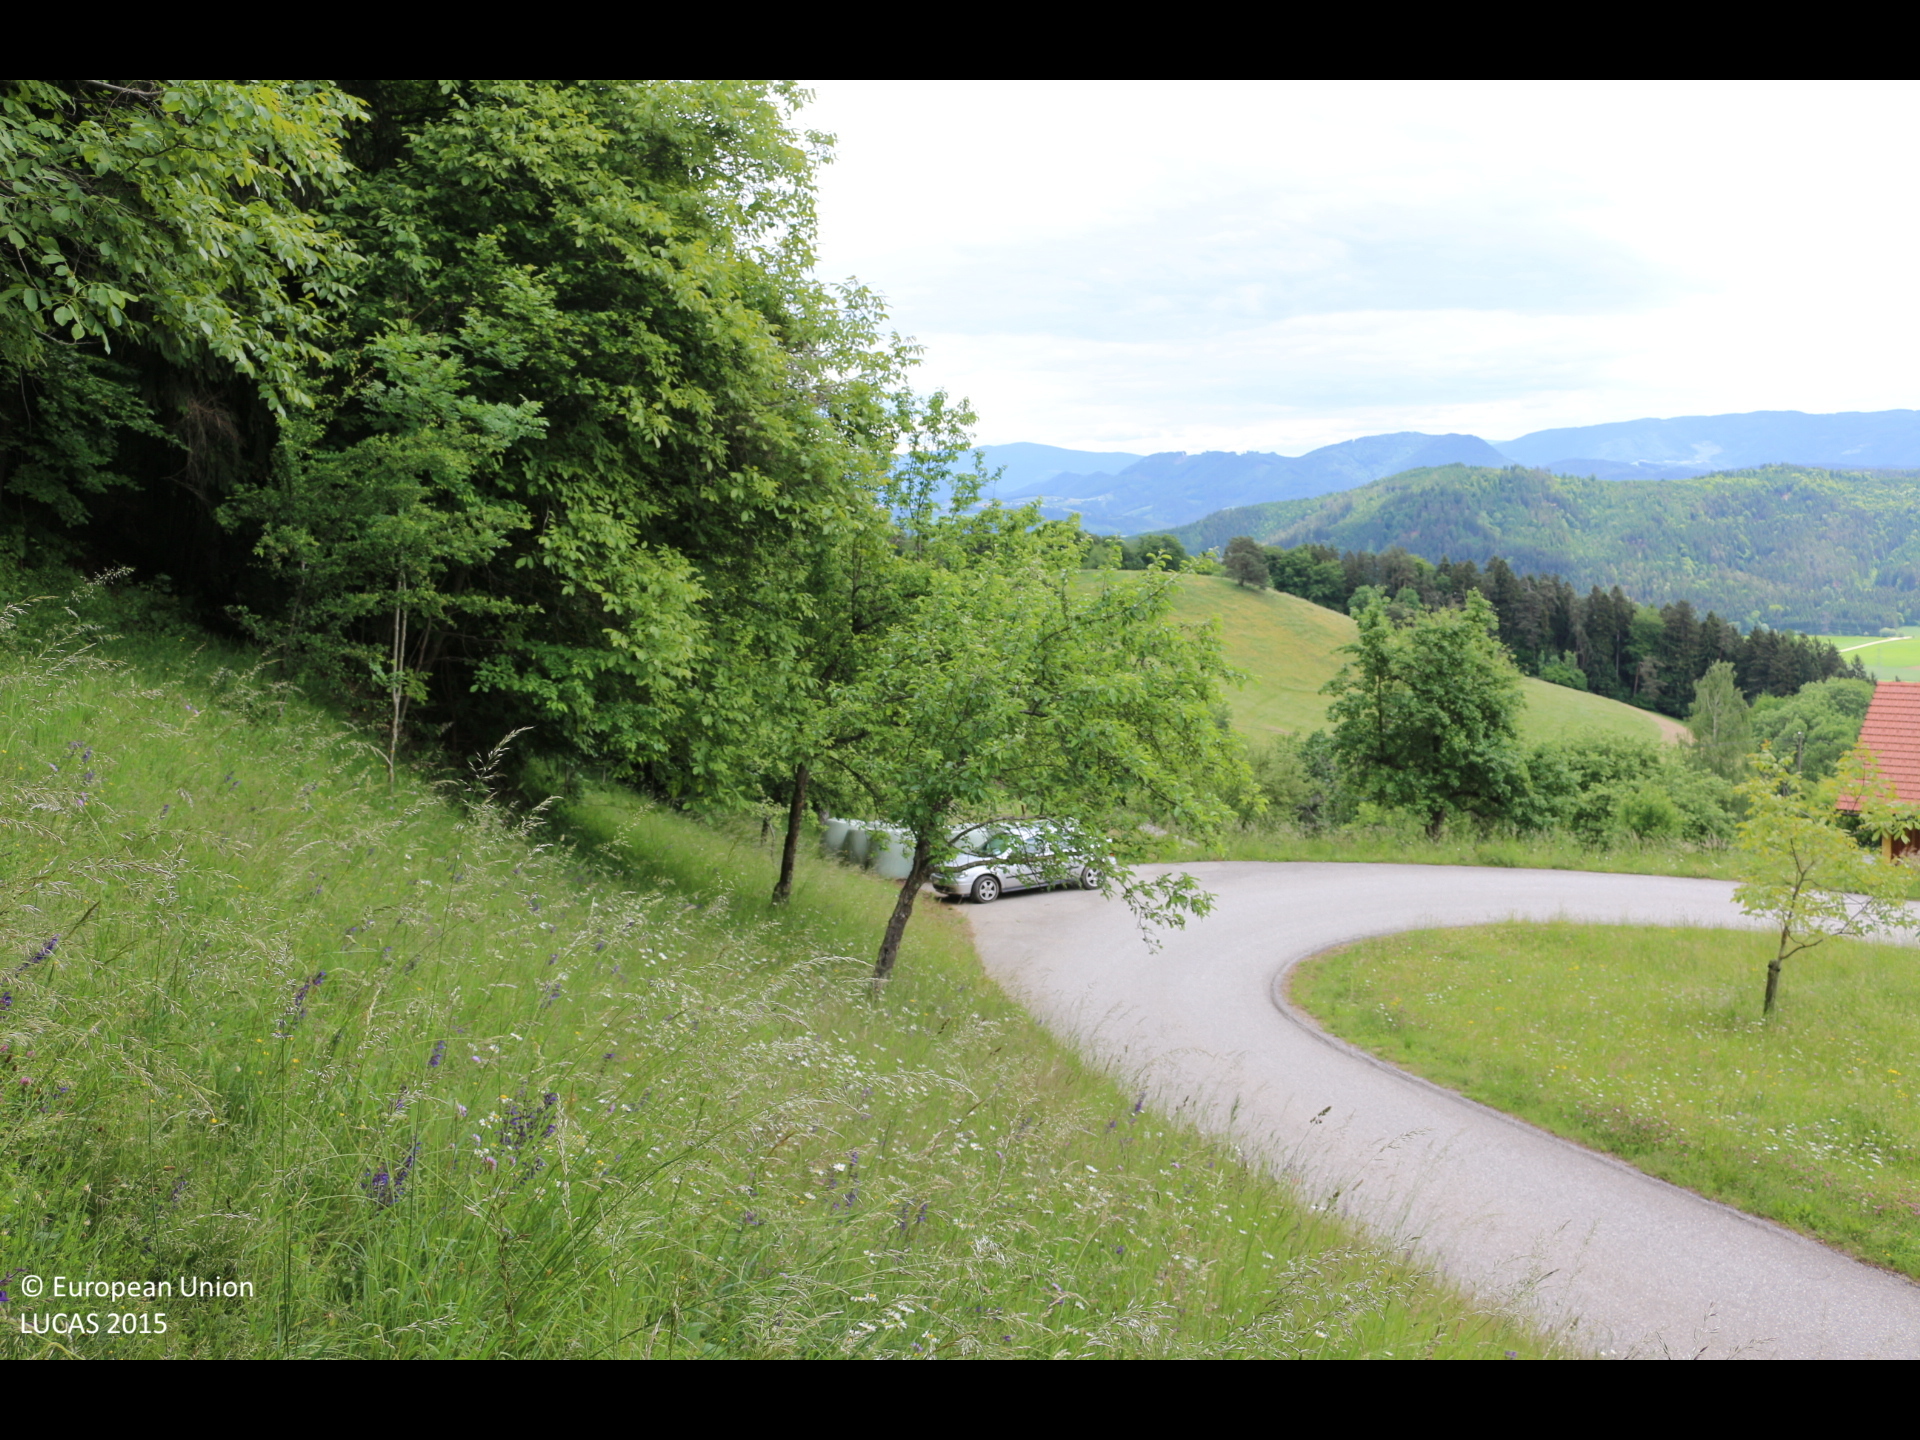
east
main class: Grassland
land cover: Grassland with sparse tree/shrub cover
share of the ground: > 75 %
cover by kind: herbaceous plants 90 %, broadleaved forest trees 5 %, shrubs 5 %
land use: Agriculture (excluding fallow land and kitchen gardens)
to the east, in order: Grassland with sparse tree/shrub cover; Spruce dominated mixed woodland; Spruce dominated coniferous woodland; Fences; Grassland with sparse tree/shrub cover; Artificial constructions in urban areas; Grassland with sparse tree/shrub cover; Paved roads, cycling and walking lanes; Grassland without tree/shrub cover
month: May
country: AT
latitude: 46.6992
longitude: 14.6930
